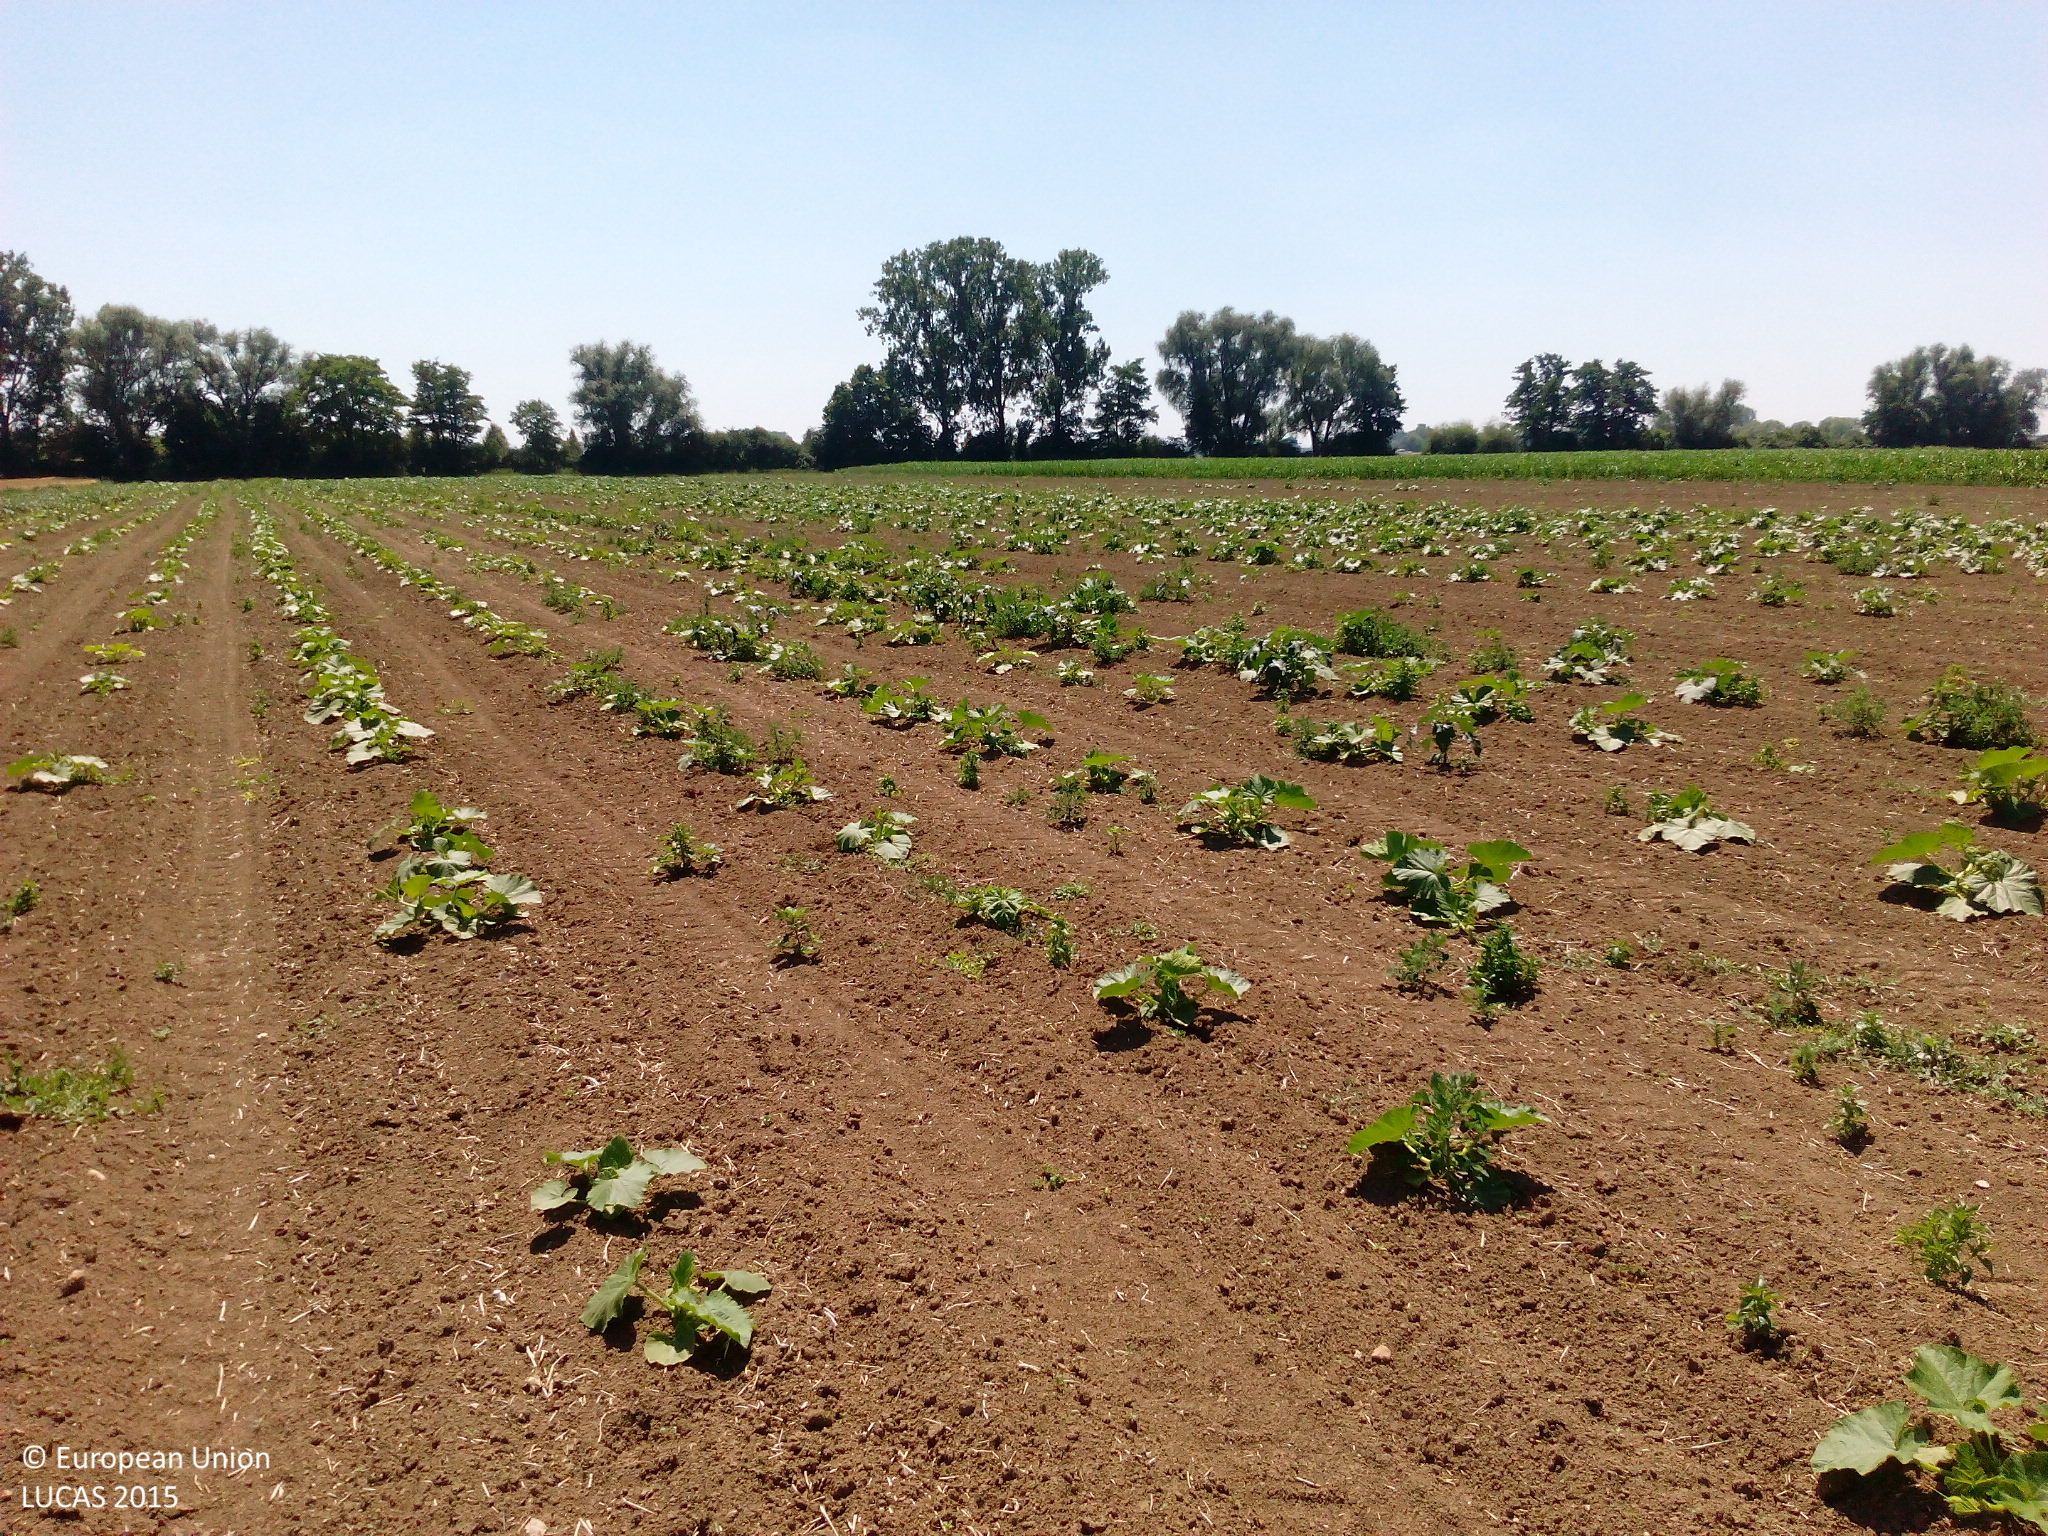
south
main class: Cropland
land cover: Other fresh vegetables
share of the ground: < 10 %
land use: Agriculture (excluding fallow land and kitchen gardens)
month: July
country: DE
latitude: 49.7972
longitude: 8.5417
